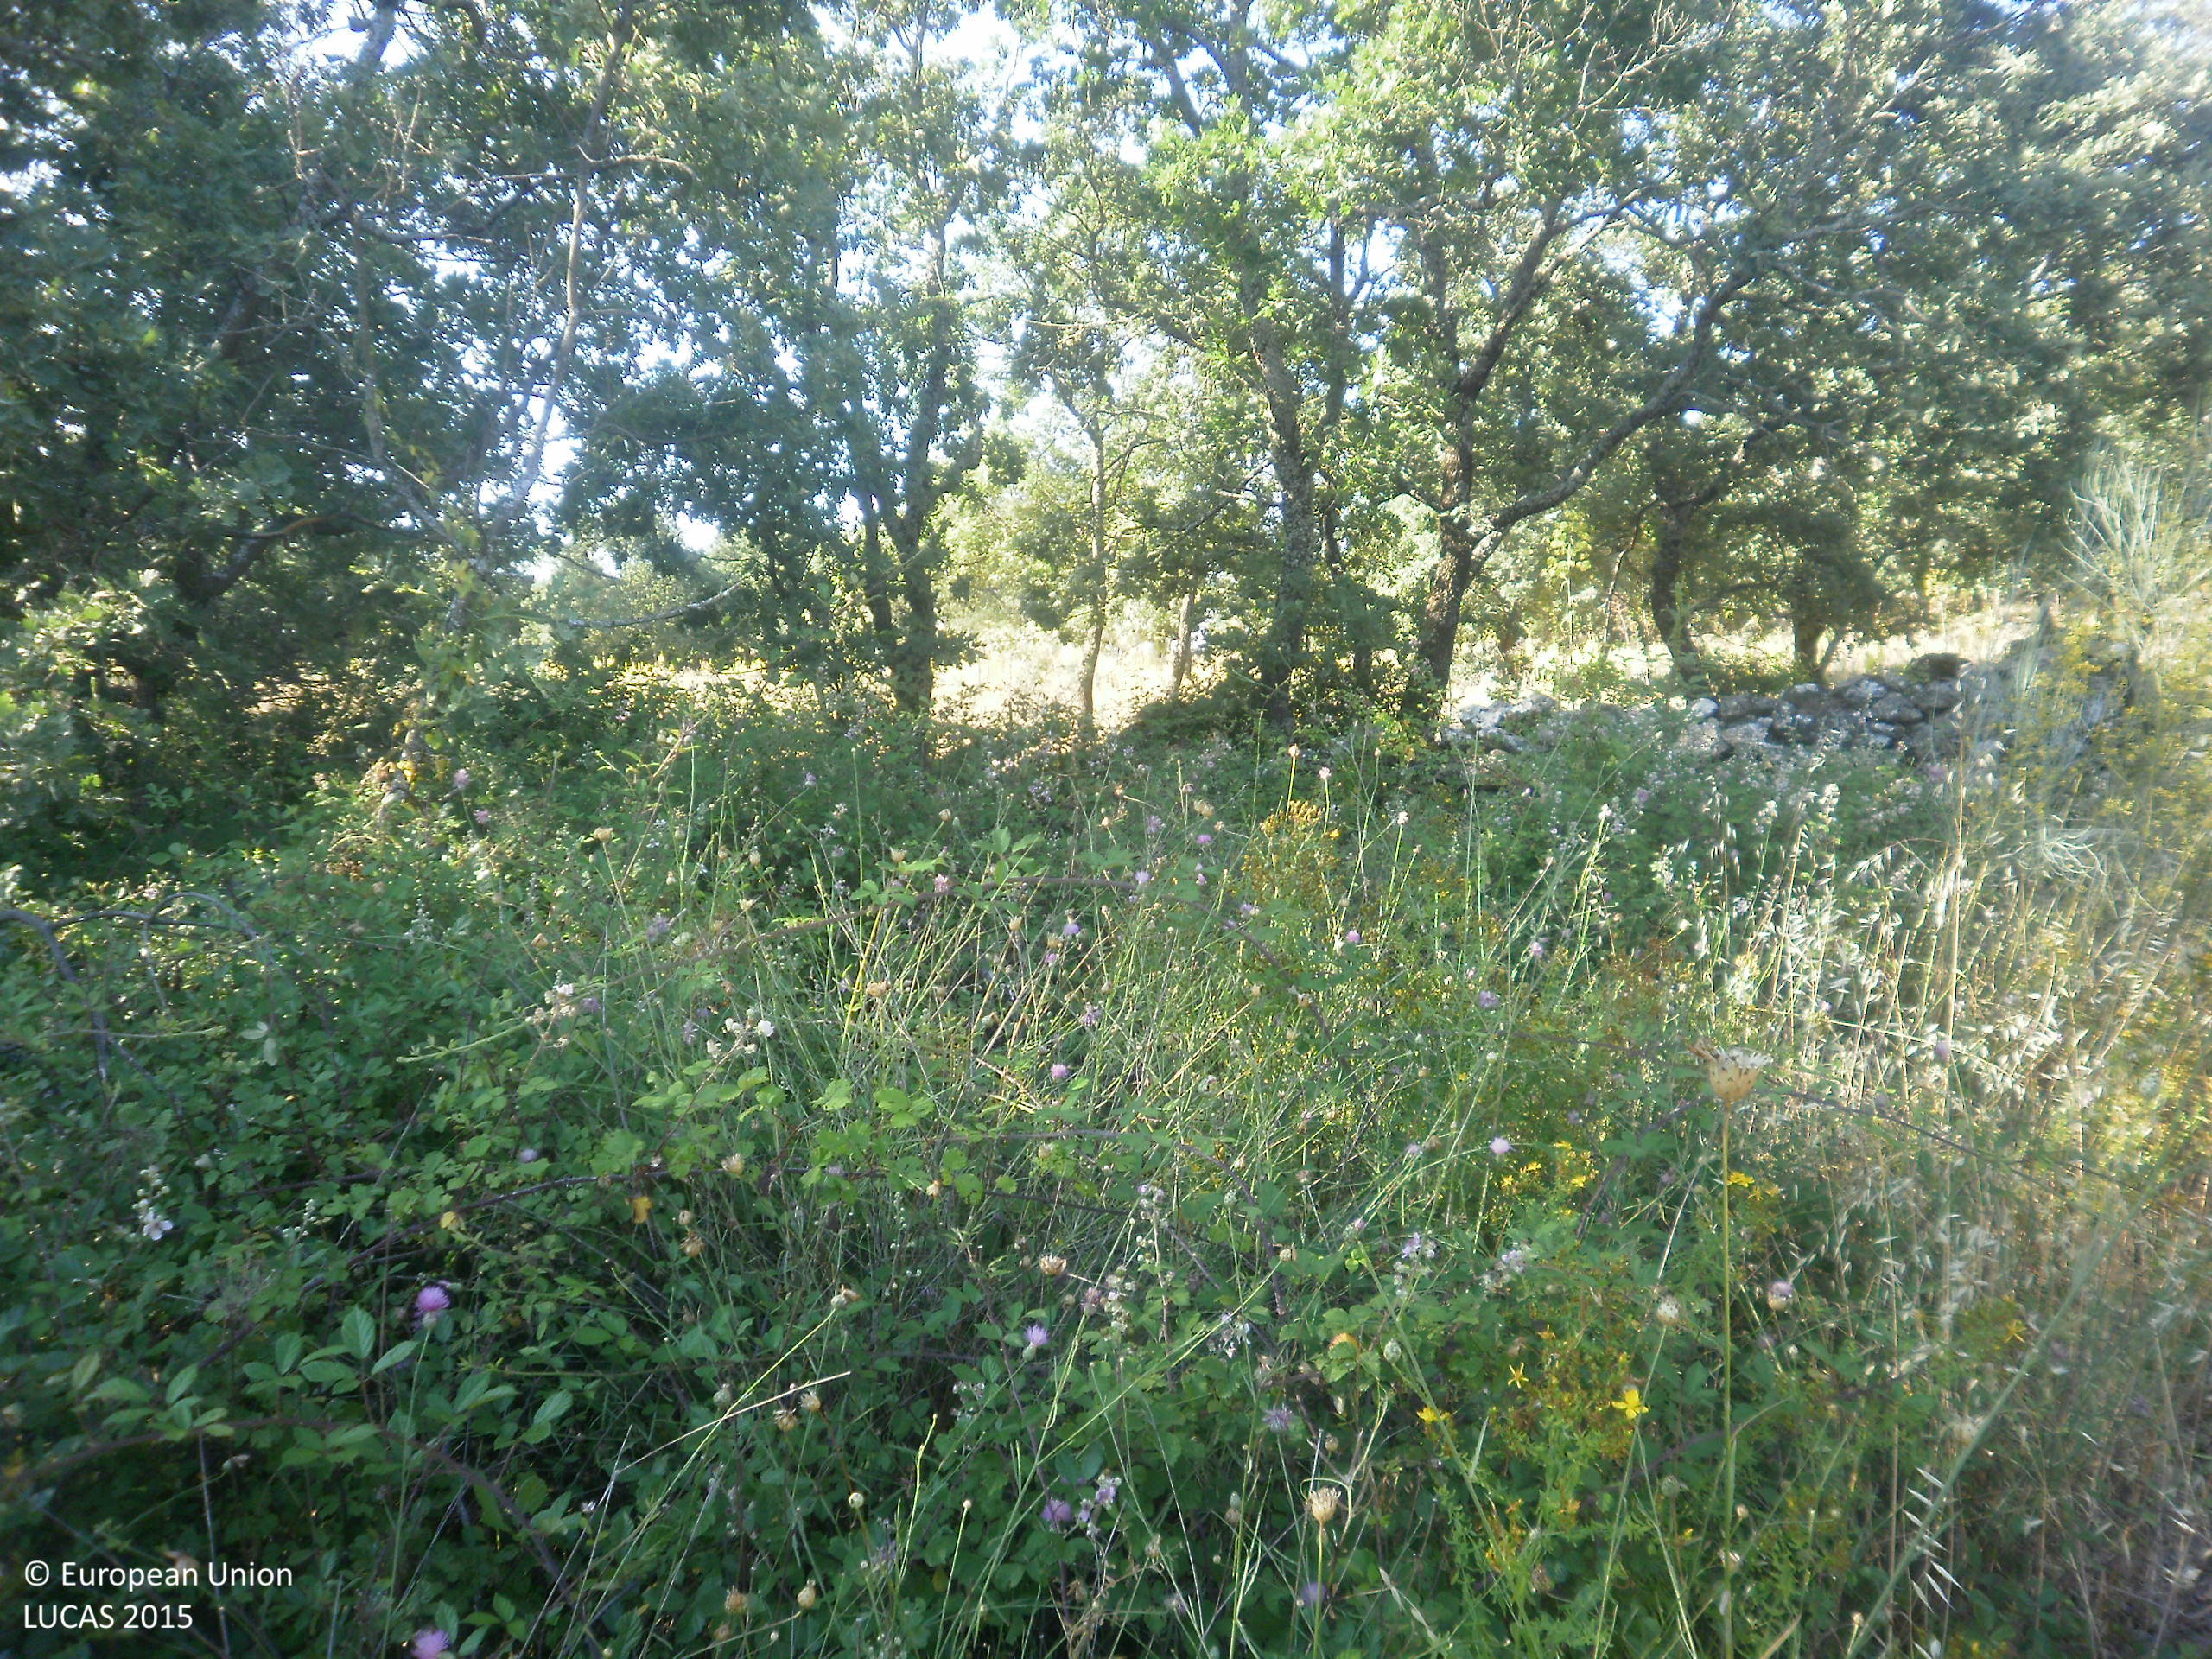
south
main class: Woodland
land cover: Broadleaved woodland
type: thermophilous deciduous forest
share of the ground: 50 - 75 %
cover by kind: broadleaved forest trees 60 %, herbaceous plants 40 %
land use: Forestry
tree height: > 5 m
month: June
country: ES
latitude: 39.2160
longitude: -6.0284
